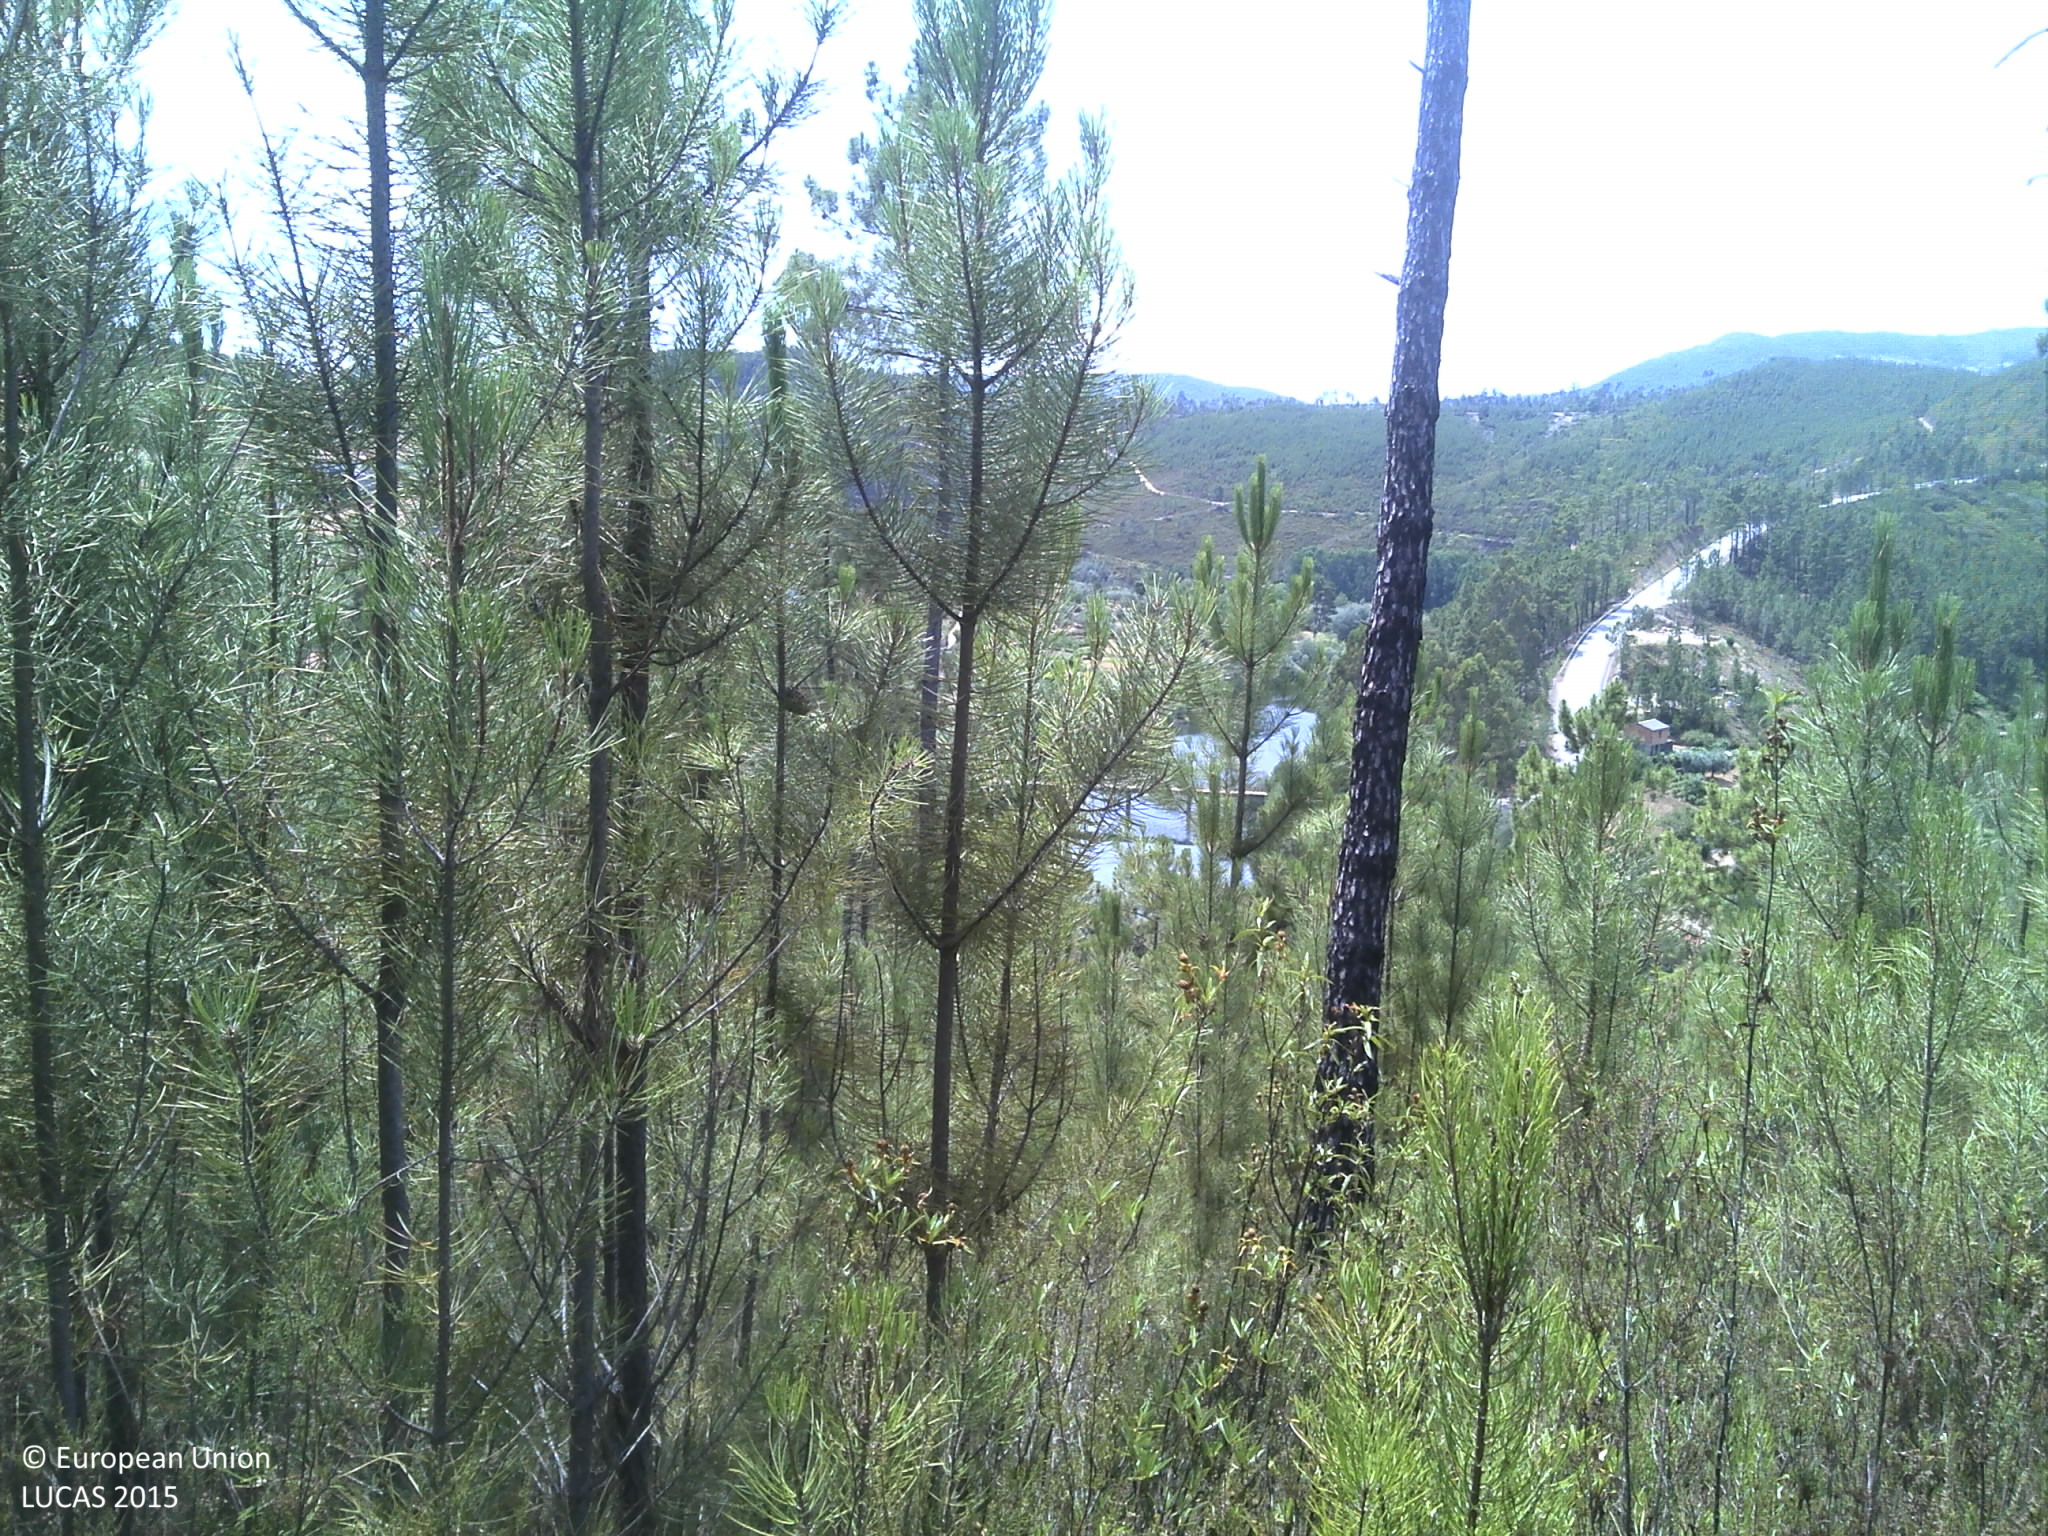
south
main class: Woodland
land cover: Pine dominated coniferous woodland
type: coniferous forest of the mediterranean region
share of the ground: 25 - 50 %
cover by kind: coniferous forest trees 50 %, shrubs 30 %, unconsolidated bare surface 20 %
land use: Forestry
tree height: < 5 m
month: July
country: PT
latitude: 40.0867
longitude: -7.7853
